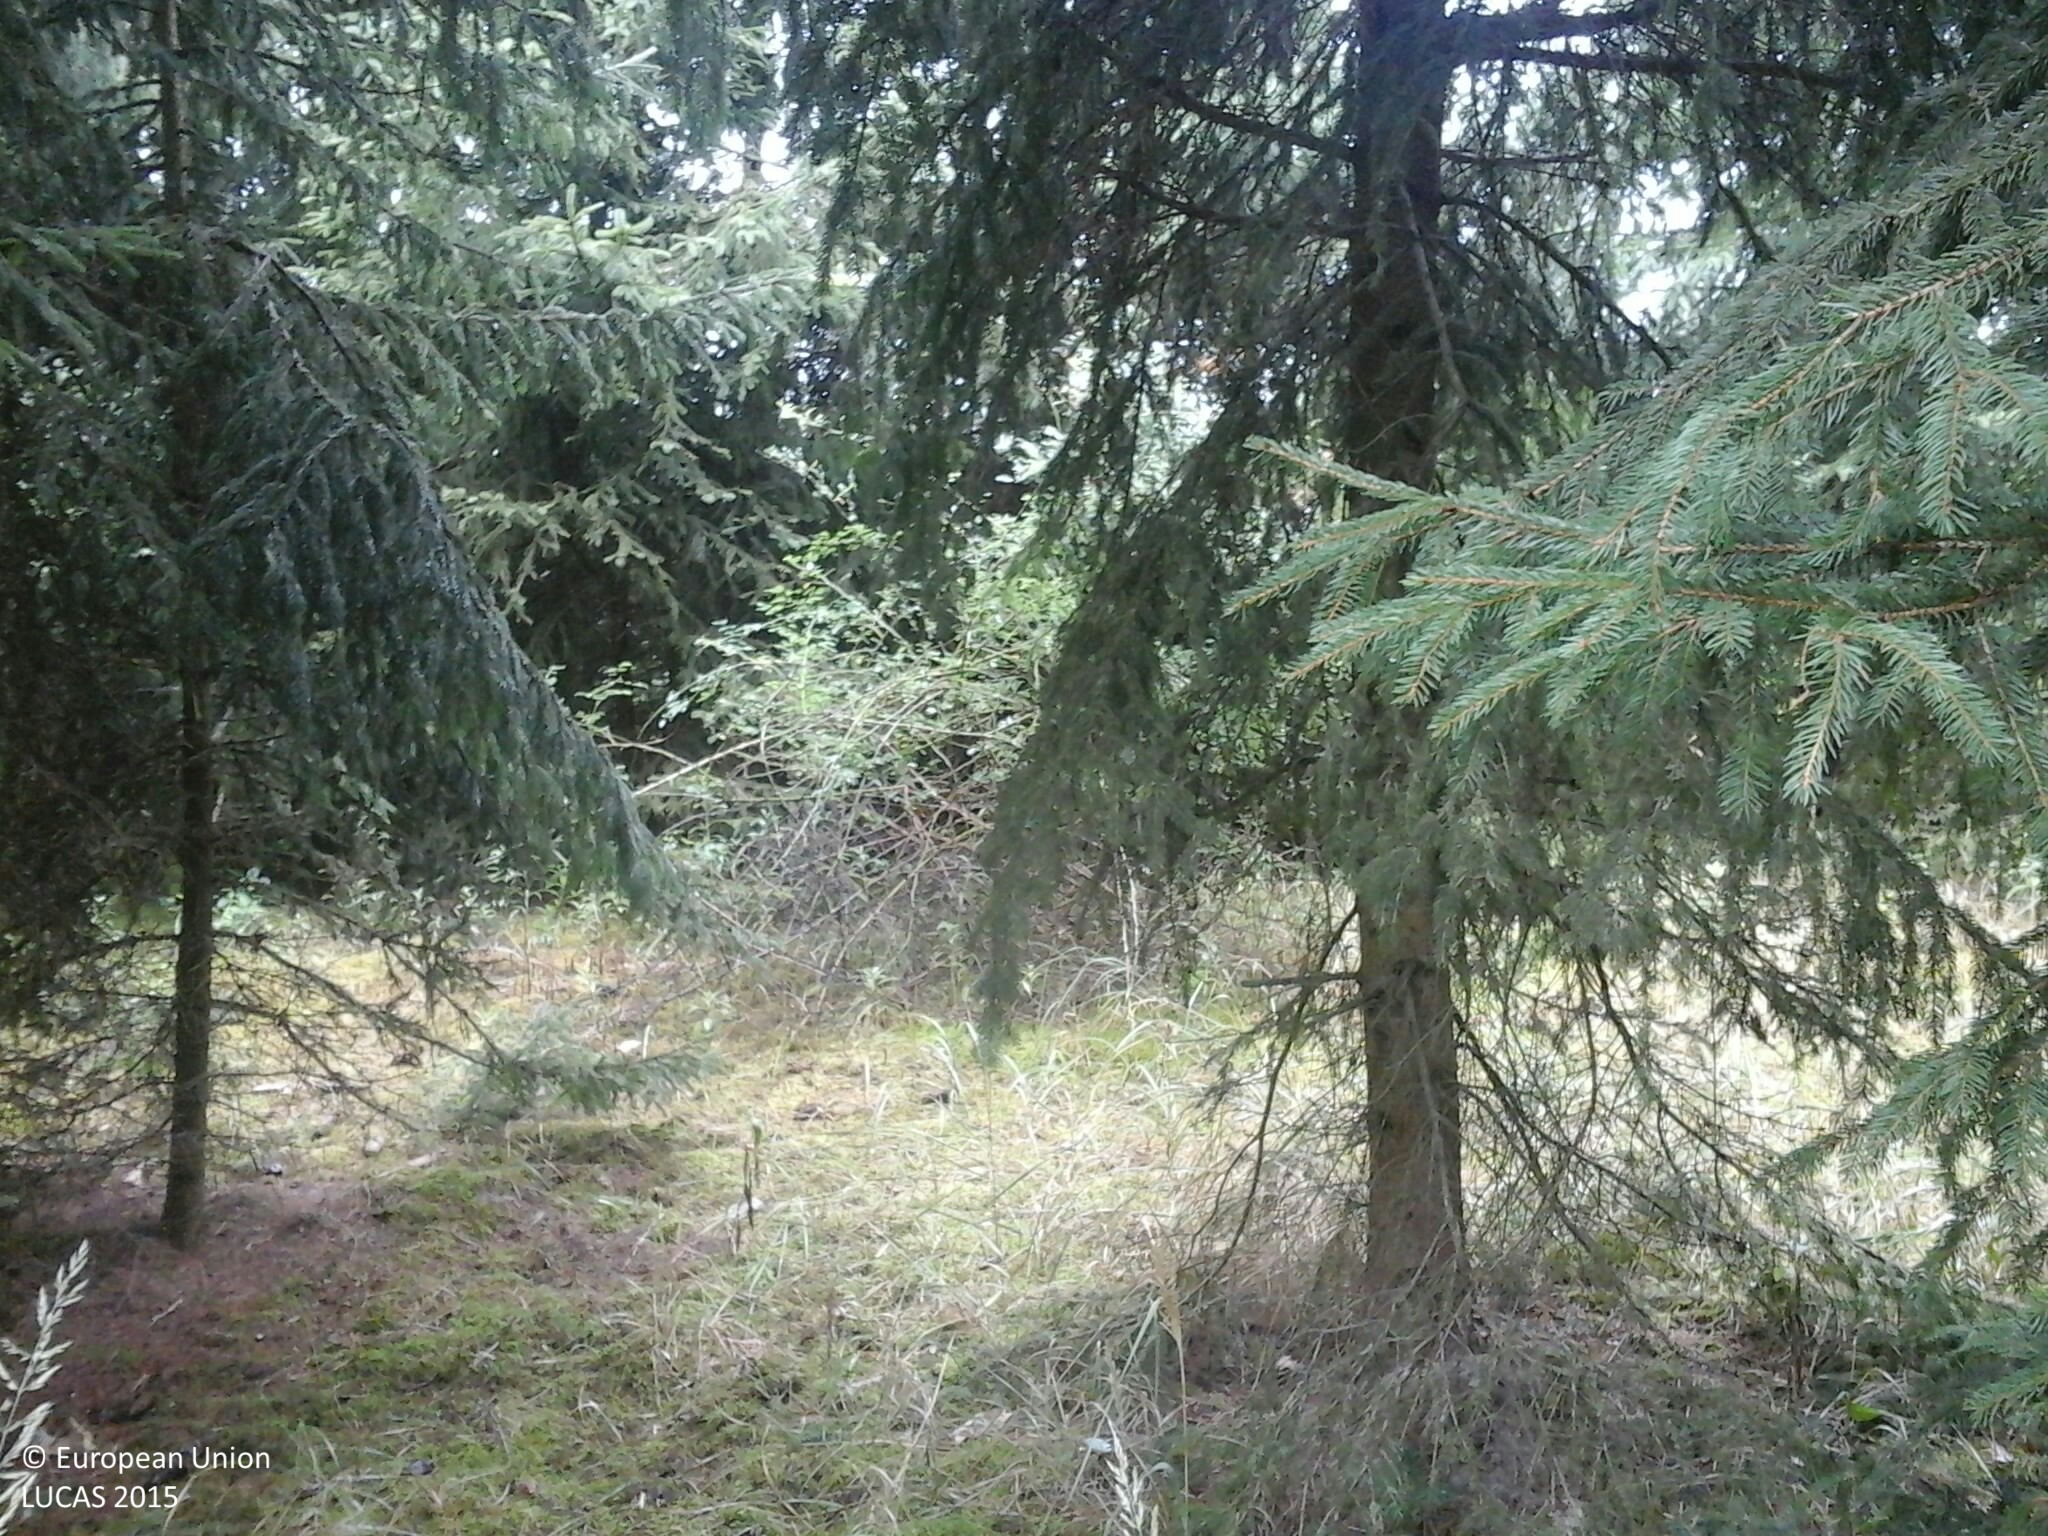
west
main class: Woodland
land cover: Spruce dominated coniferous woodland
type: hemiboreal forest and nemoral coniferous forest and mixed broadleaved-coniferous forest
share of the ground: > 75 %
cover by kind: coniferous forest trees 80 %, herbaceous plants 20 %
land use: Forestry
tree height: > 5 m
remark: Nursery
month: July
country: HU
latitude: 46.8583
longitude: 16.4948
